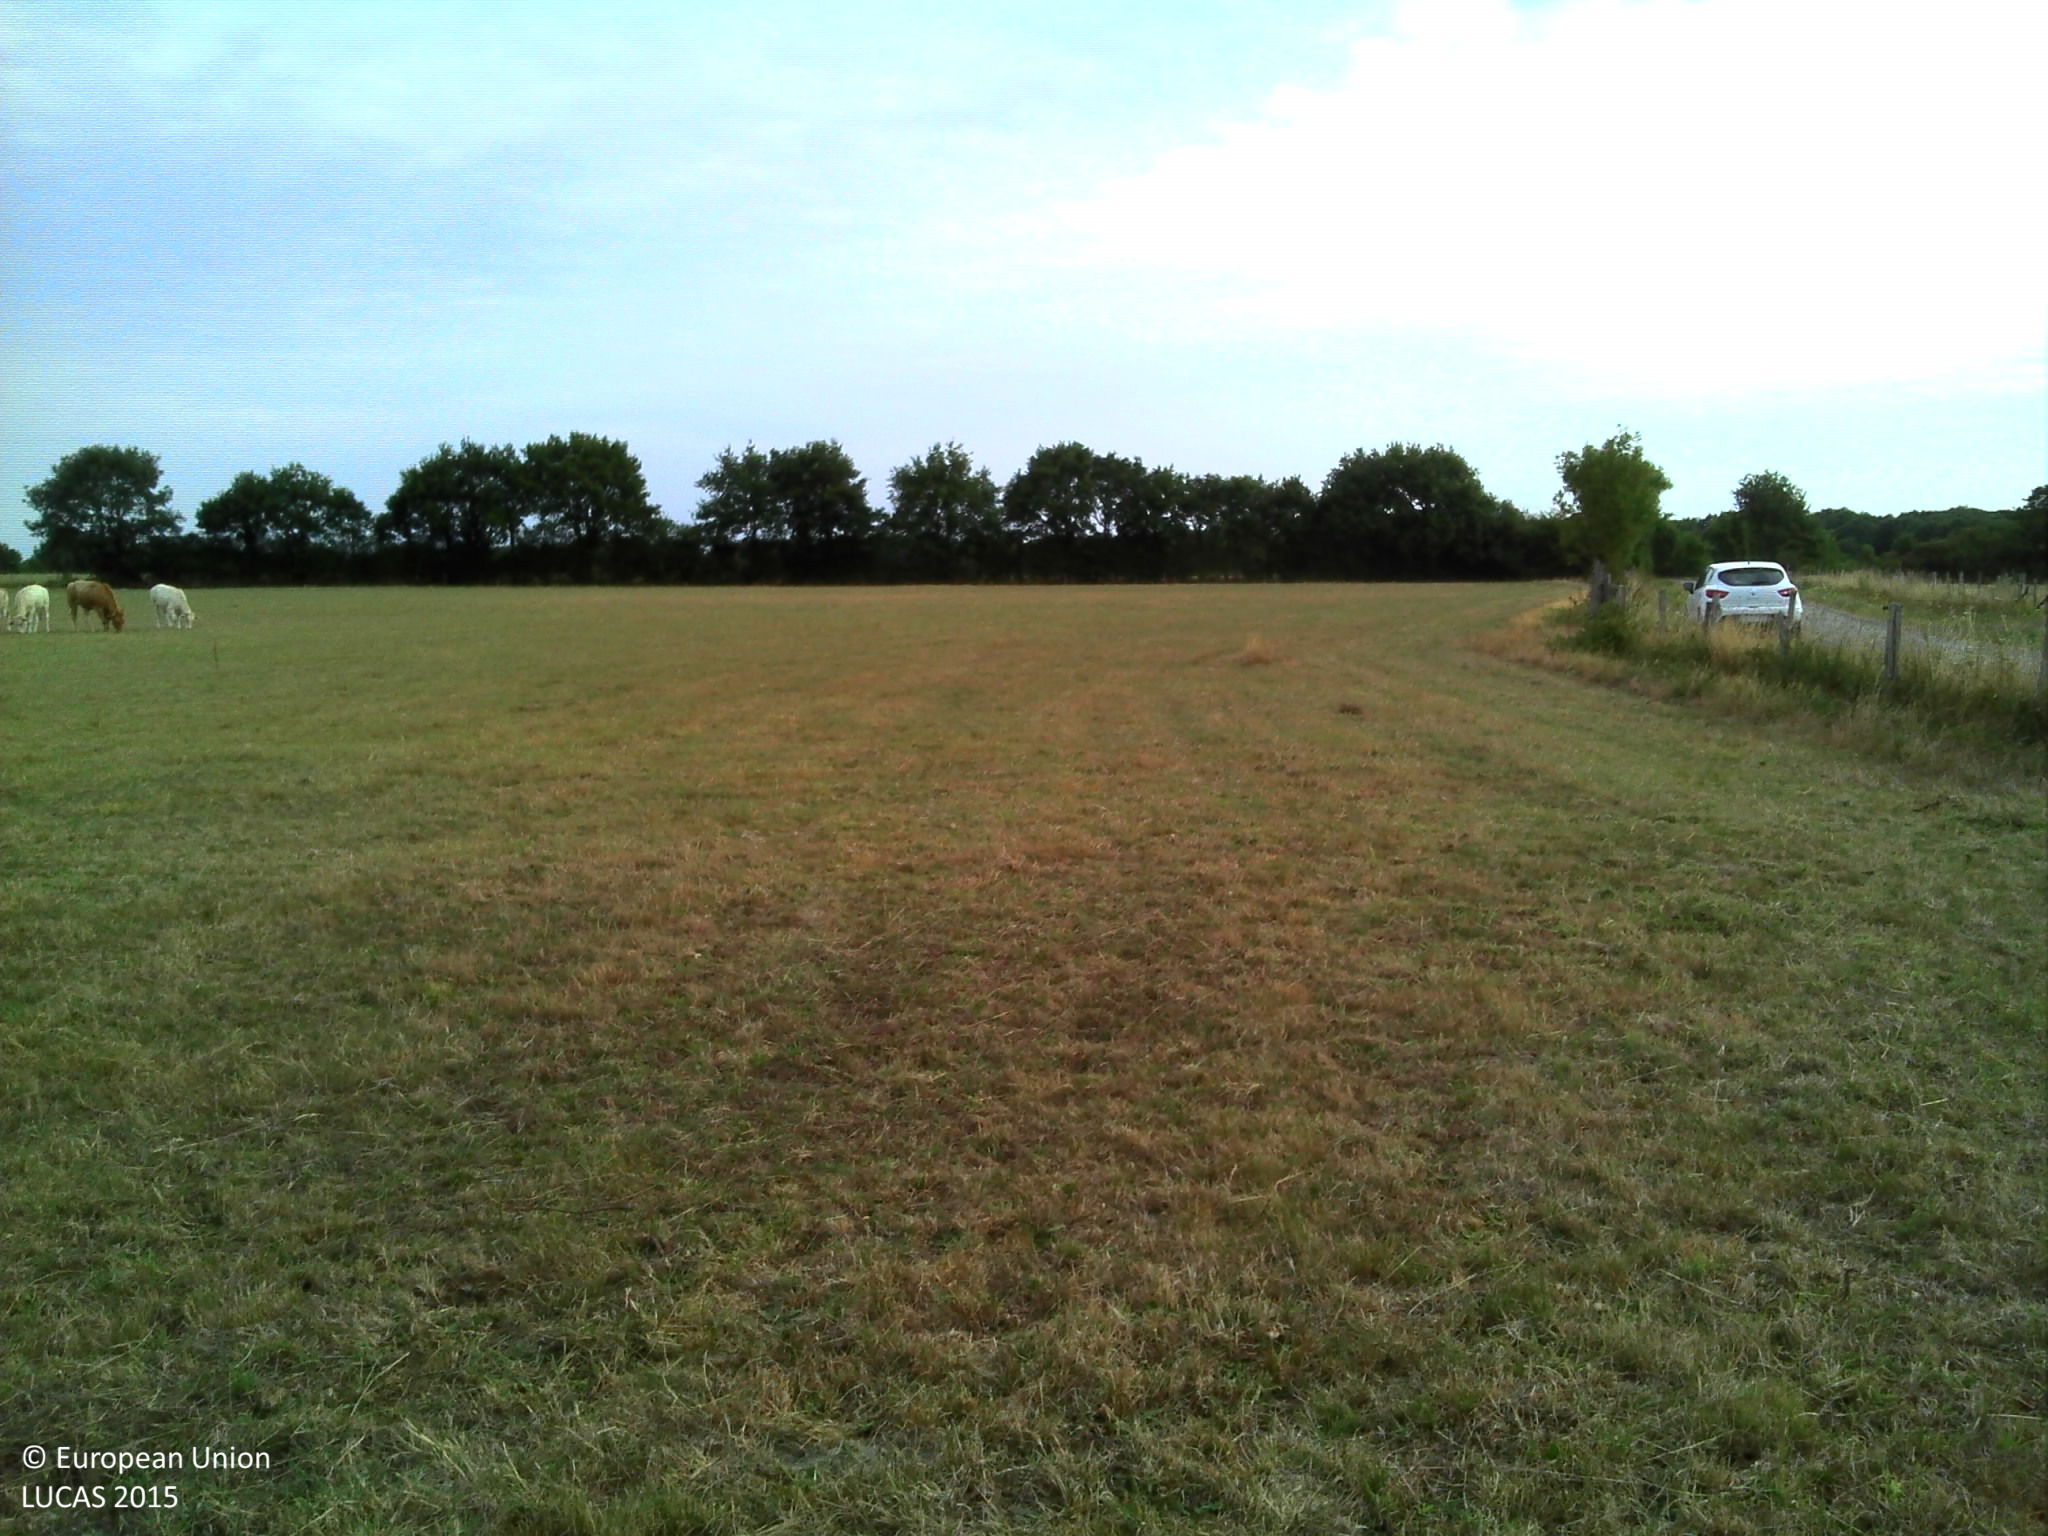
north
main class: Cropland
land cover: Temporary grasslands
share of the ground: > 75 %
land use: Agriculture (excluding fallow land and kitchen gardens)
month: August
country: FR
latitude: 47.4458
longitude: -1.5946
